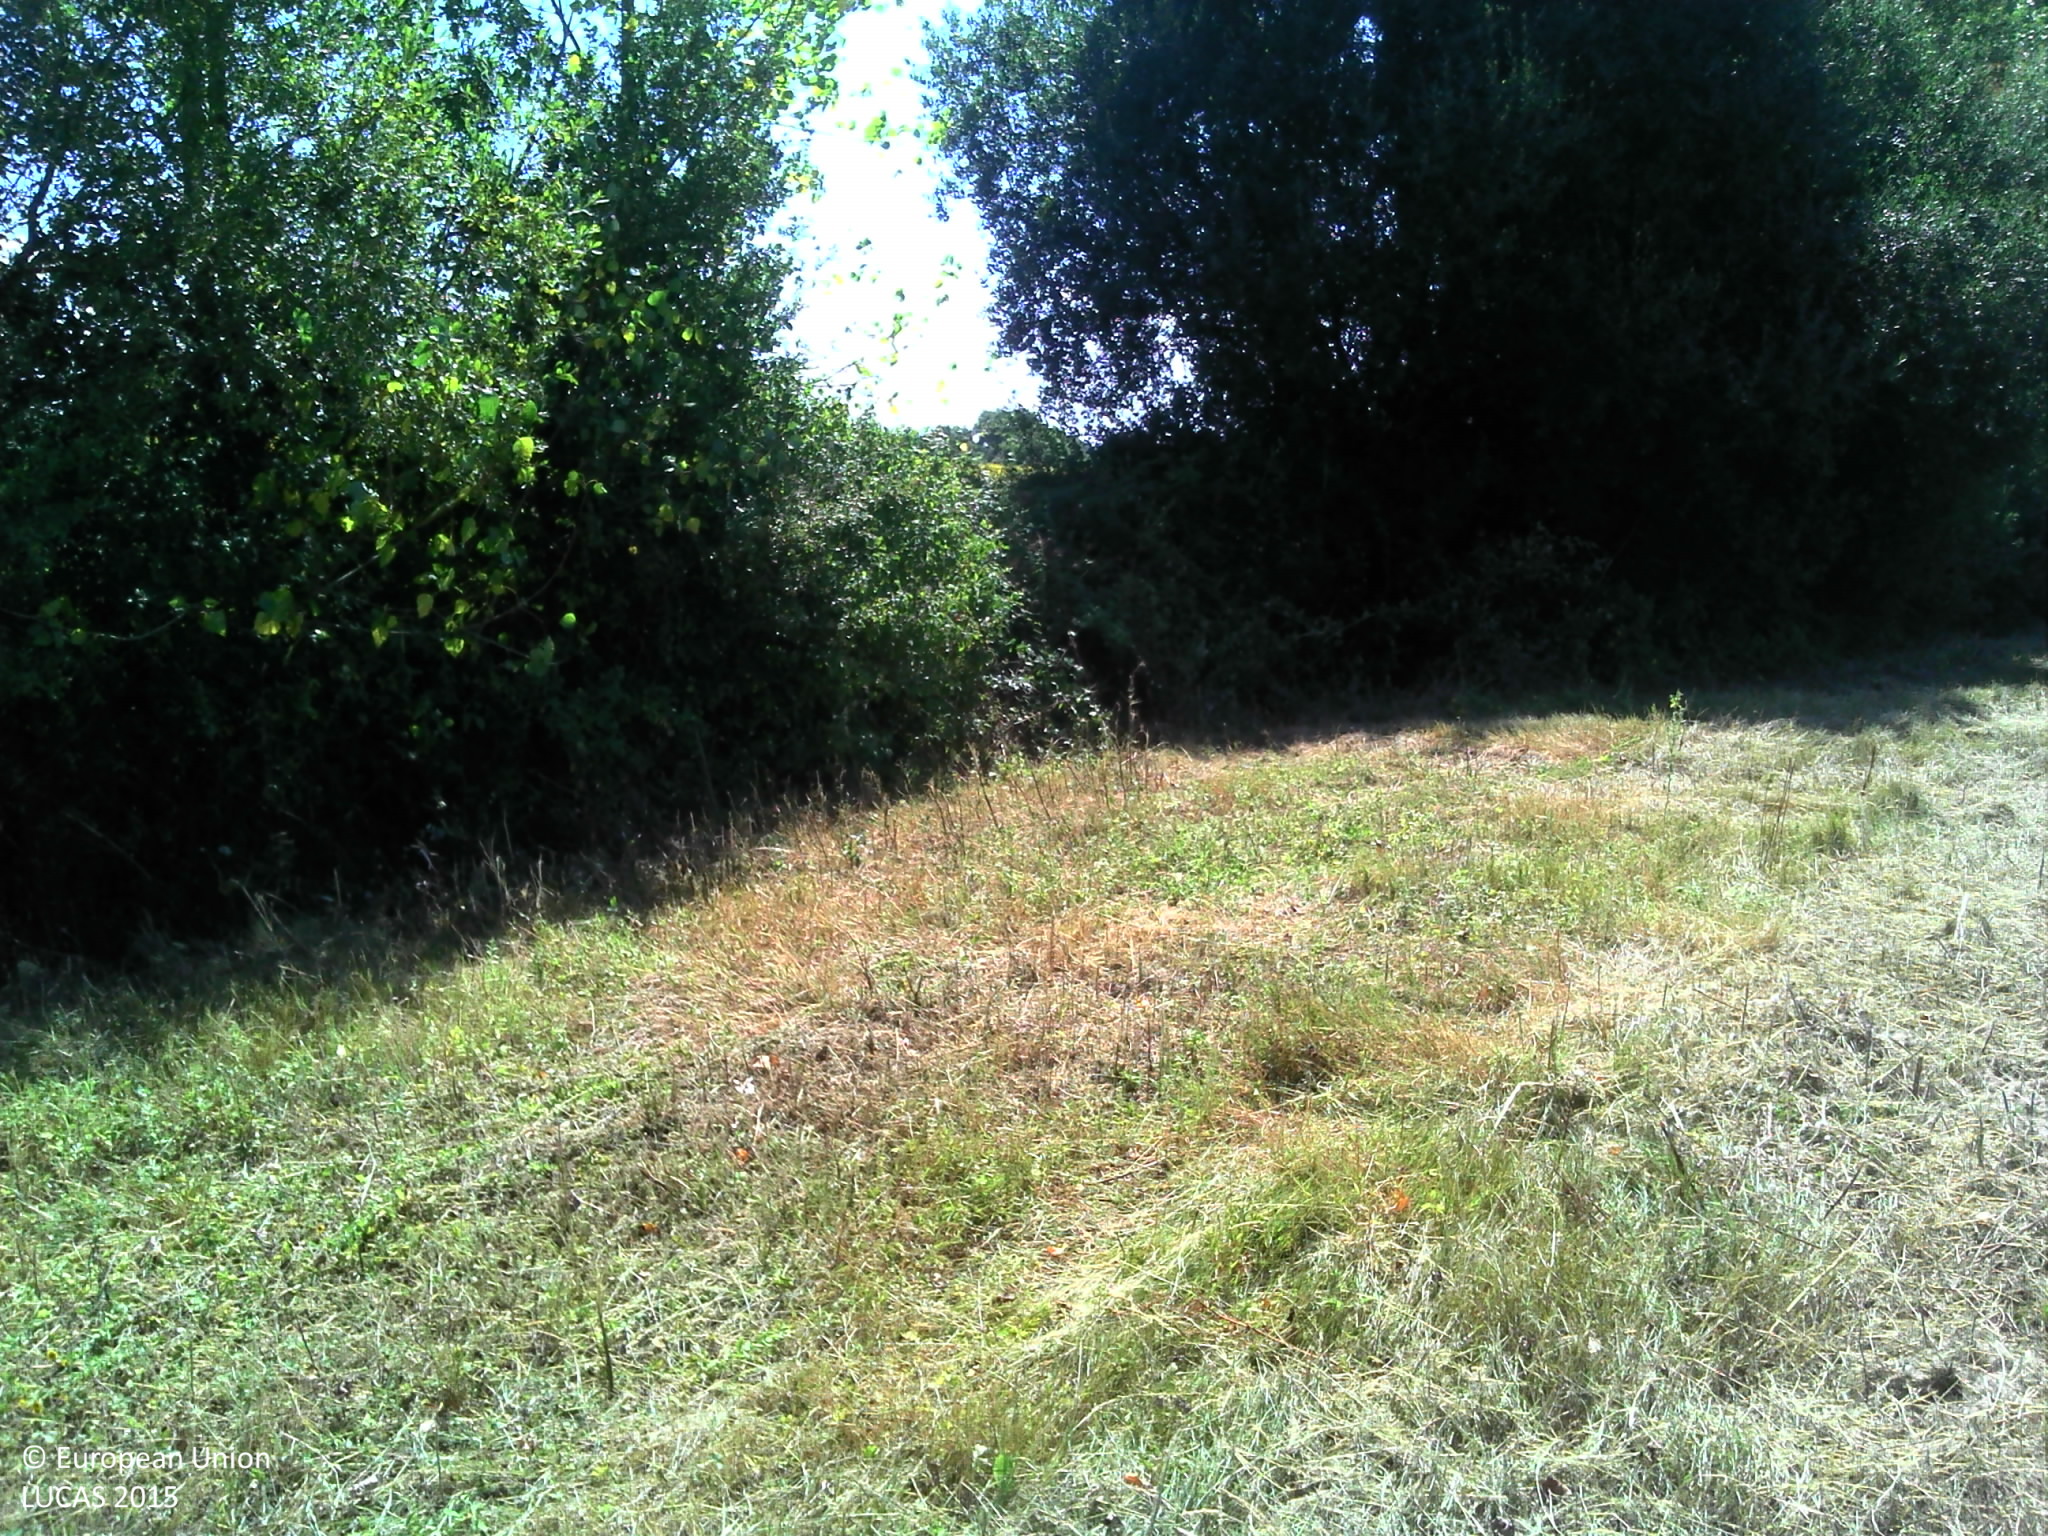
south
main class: Cropland
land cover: Dry pulses
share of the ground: 25 - 50 %
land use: Agriculture (excluding fallow land and kitchen gardens)
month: August
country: FR
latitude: 46.7737
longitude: -1.0740
